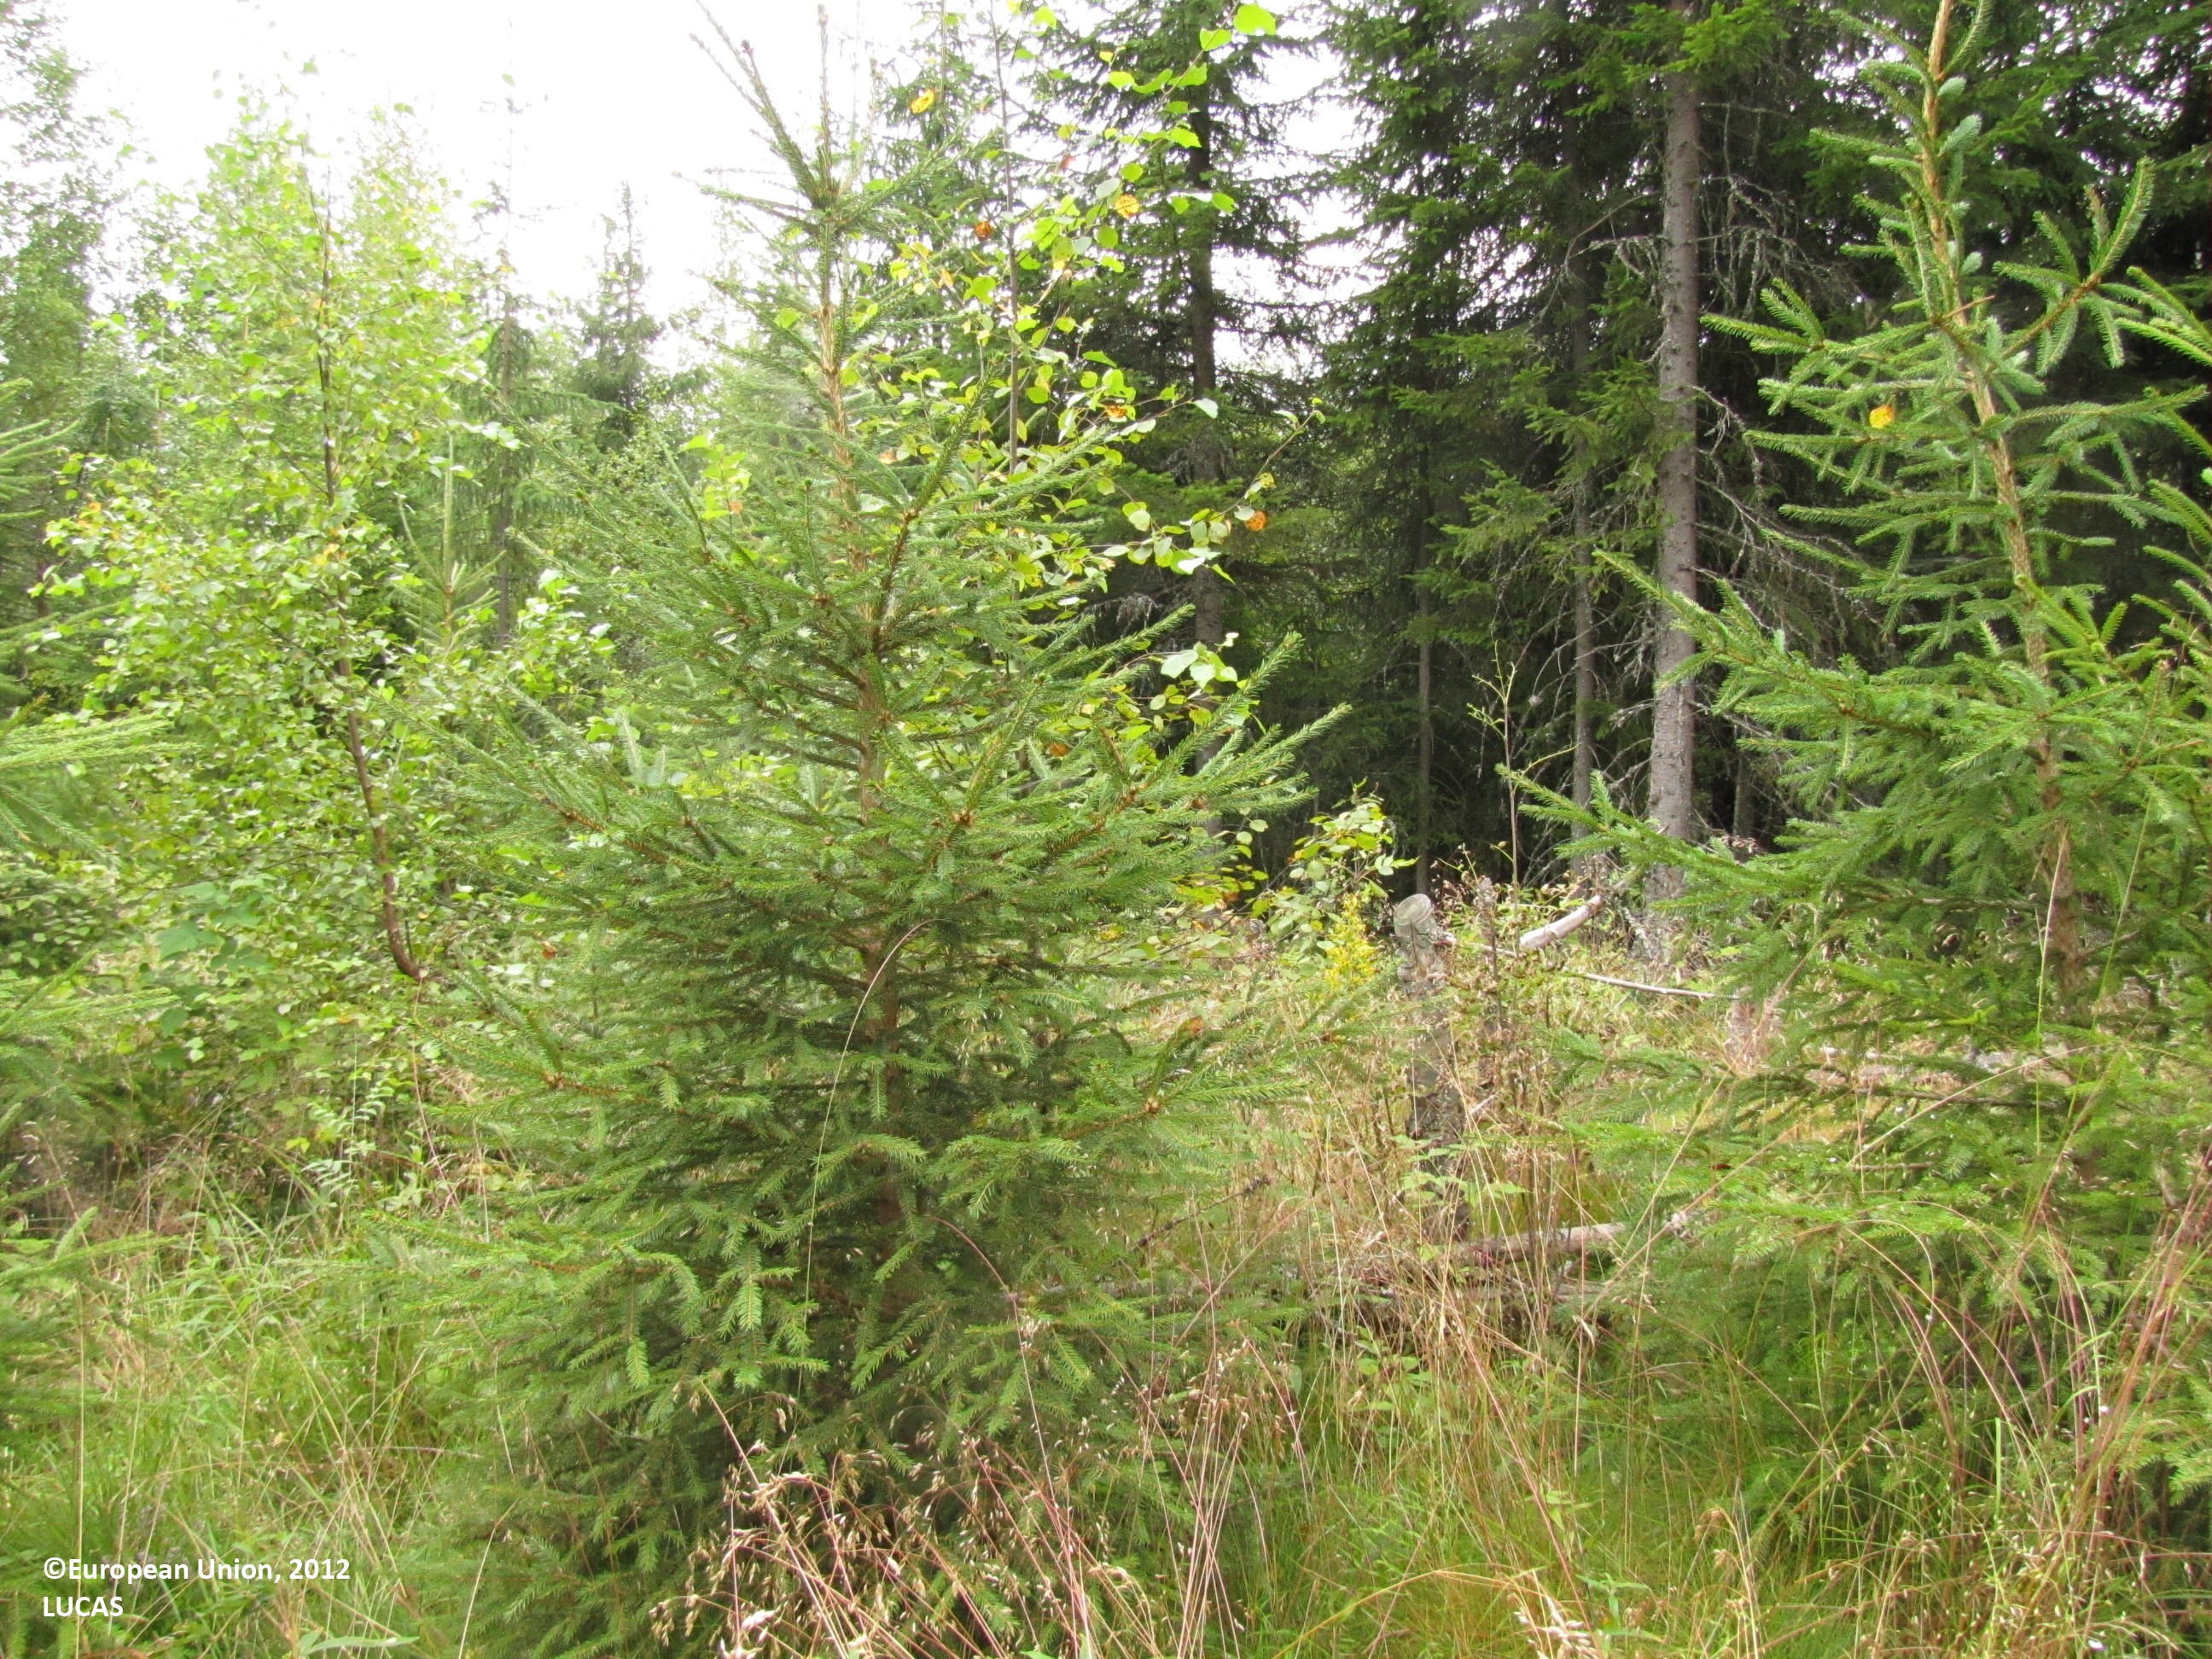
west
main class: Woodland
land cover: Spruce dominated coniferous woodland
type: boreal forest
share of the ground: 25 - 50 %
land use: Forestry
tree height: < 5 m
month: August
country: FI
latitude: 61.8449
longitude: 23.1987
